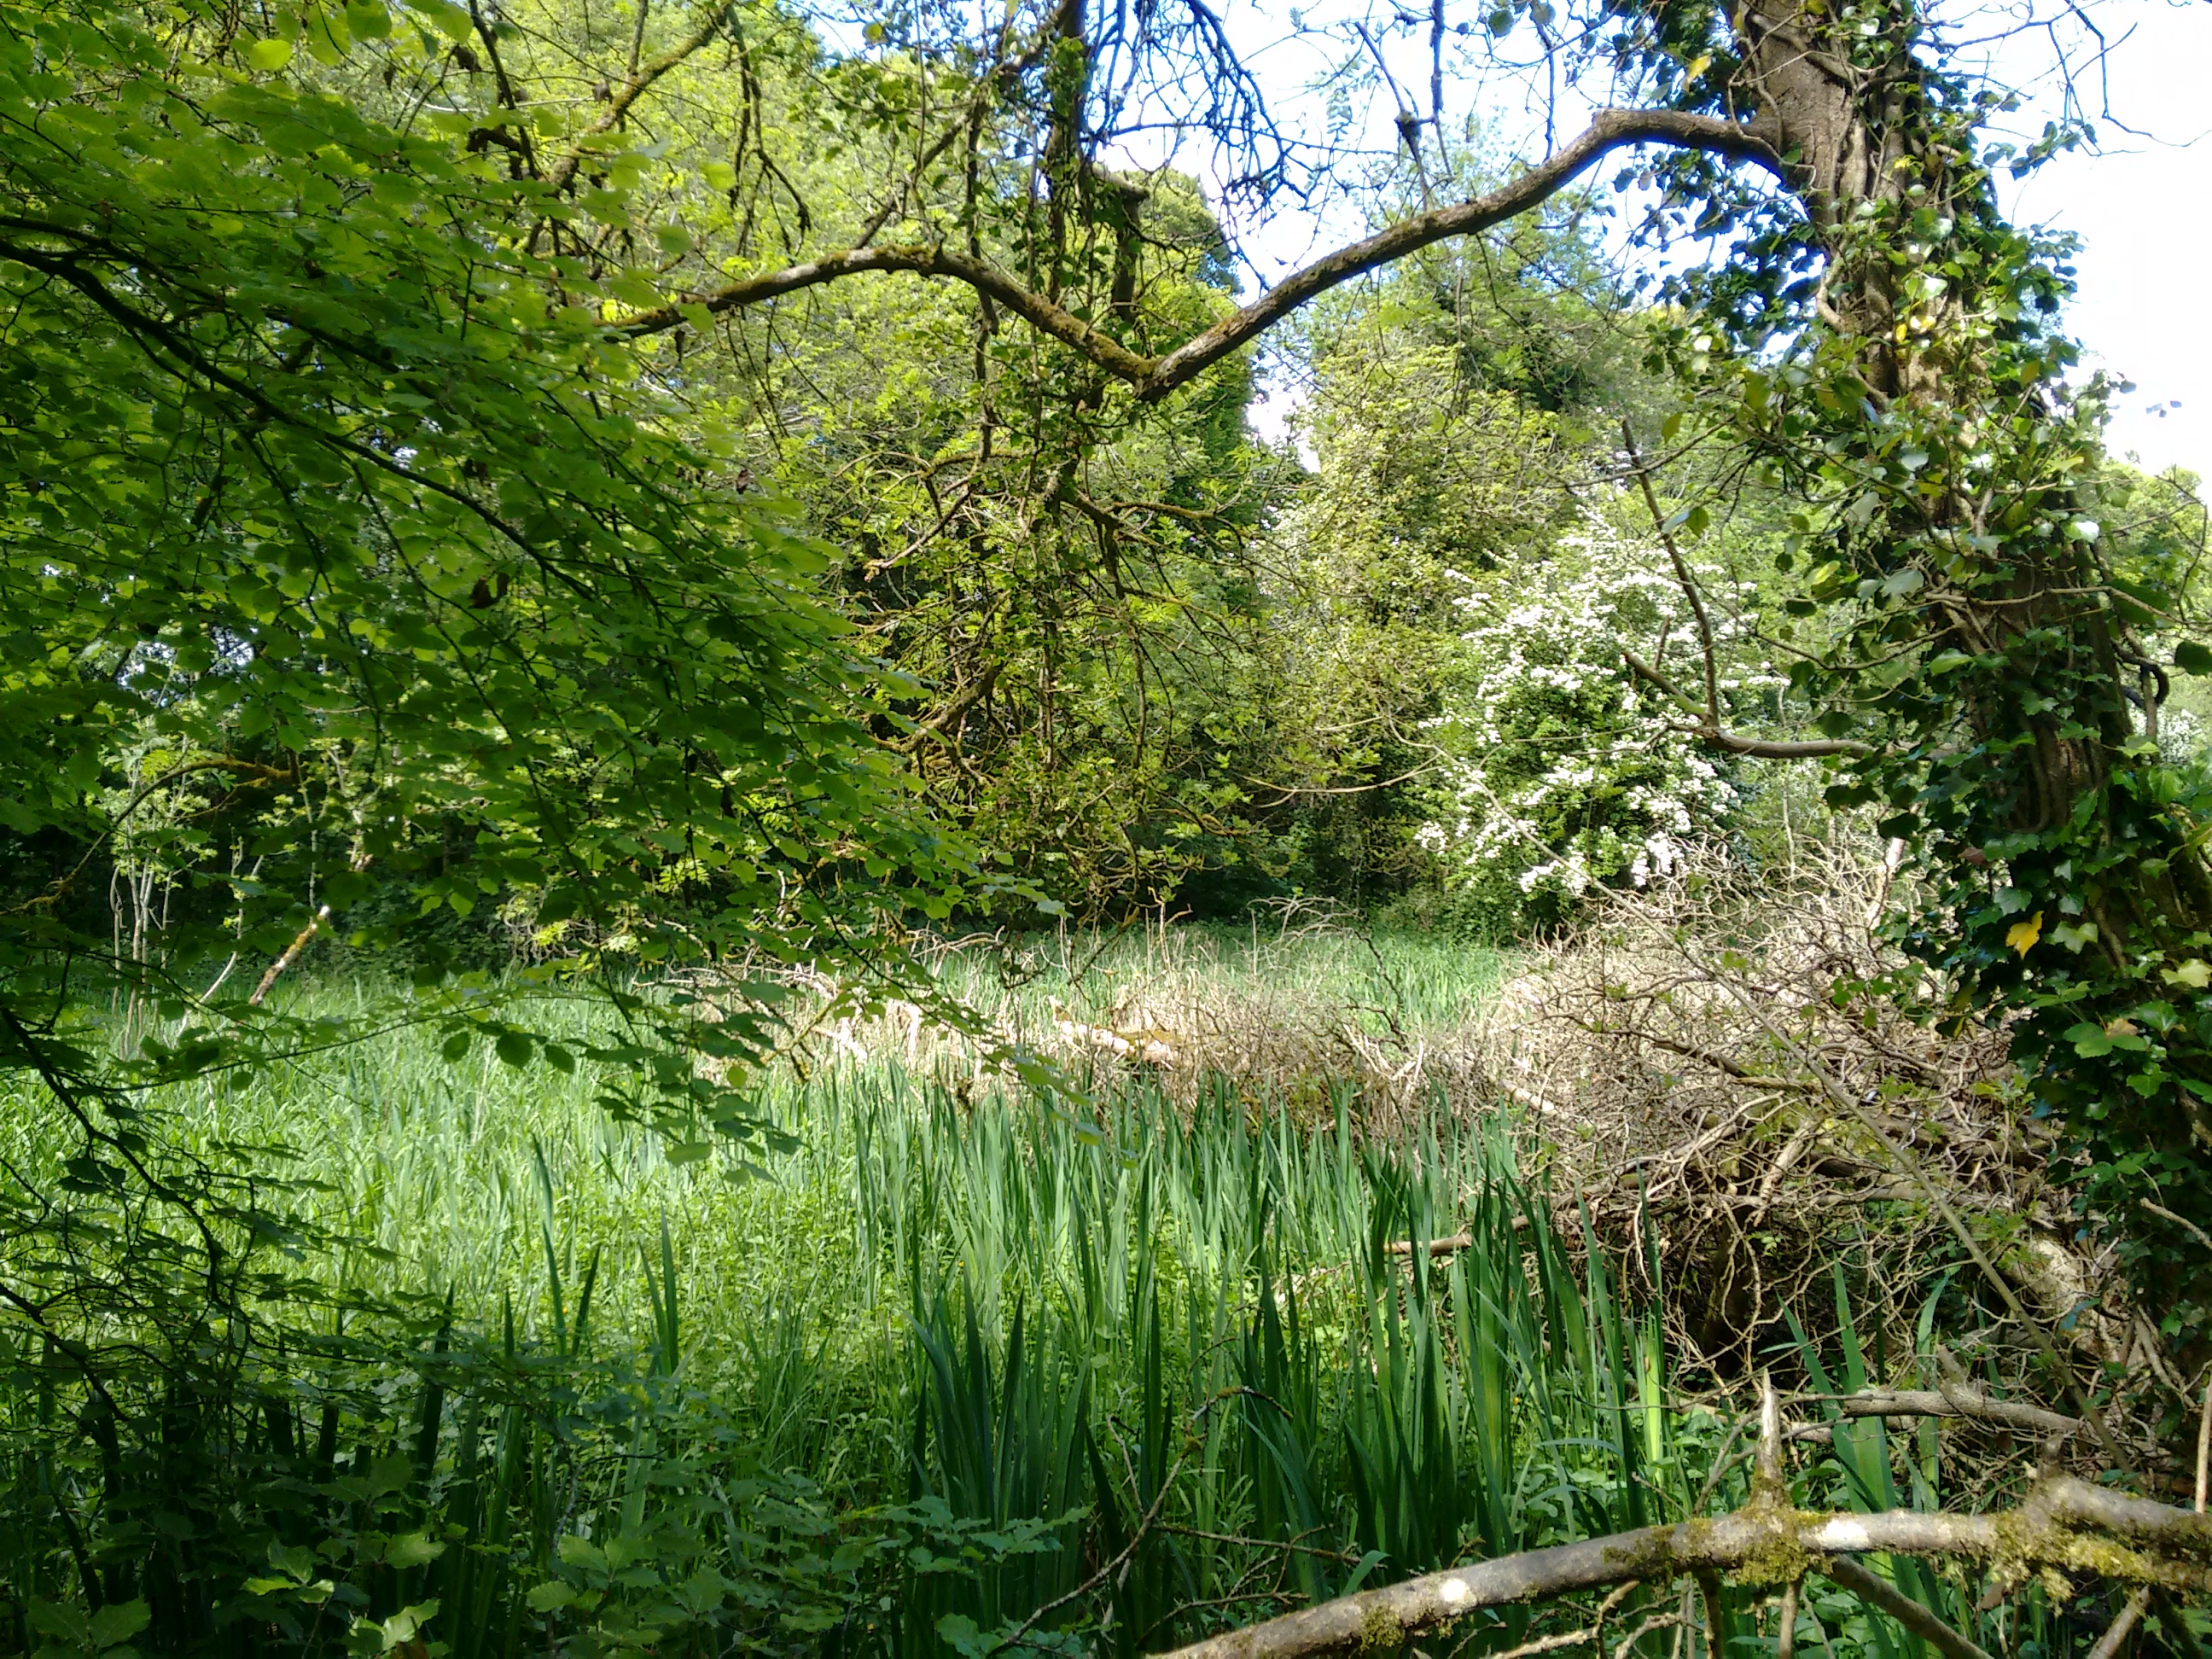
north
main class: Woodland
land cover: Broadleaved woodland
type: beech forest
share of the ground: > 75 %
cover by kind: broadleaved forest trees 85 %, shrubs 10 %, herbaceous plants 5 %
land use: Semi-natural and natural areas not in use
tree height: > 5 m
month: May
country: IE
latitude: 53.5901
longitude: -6.7056
